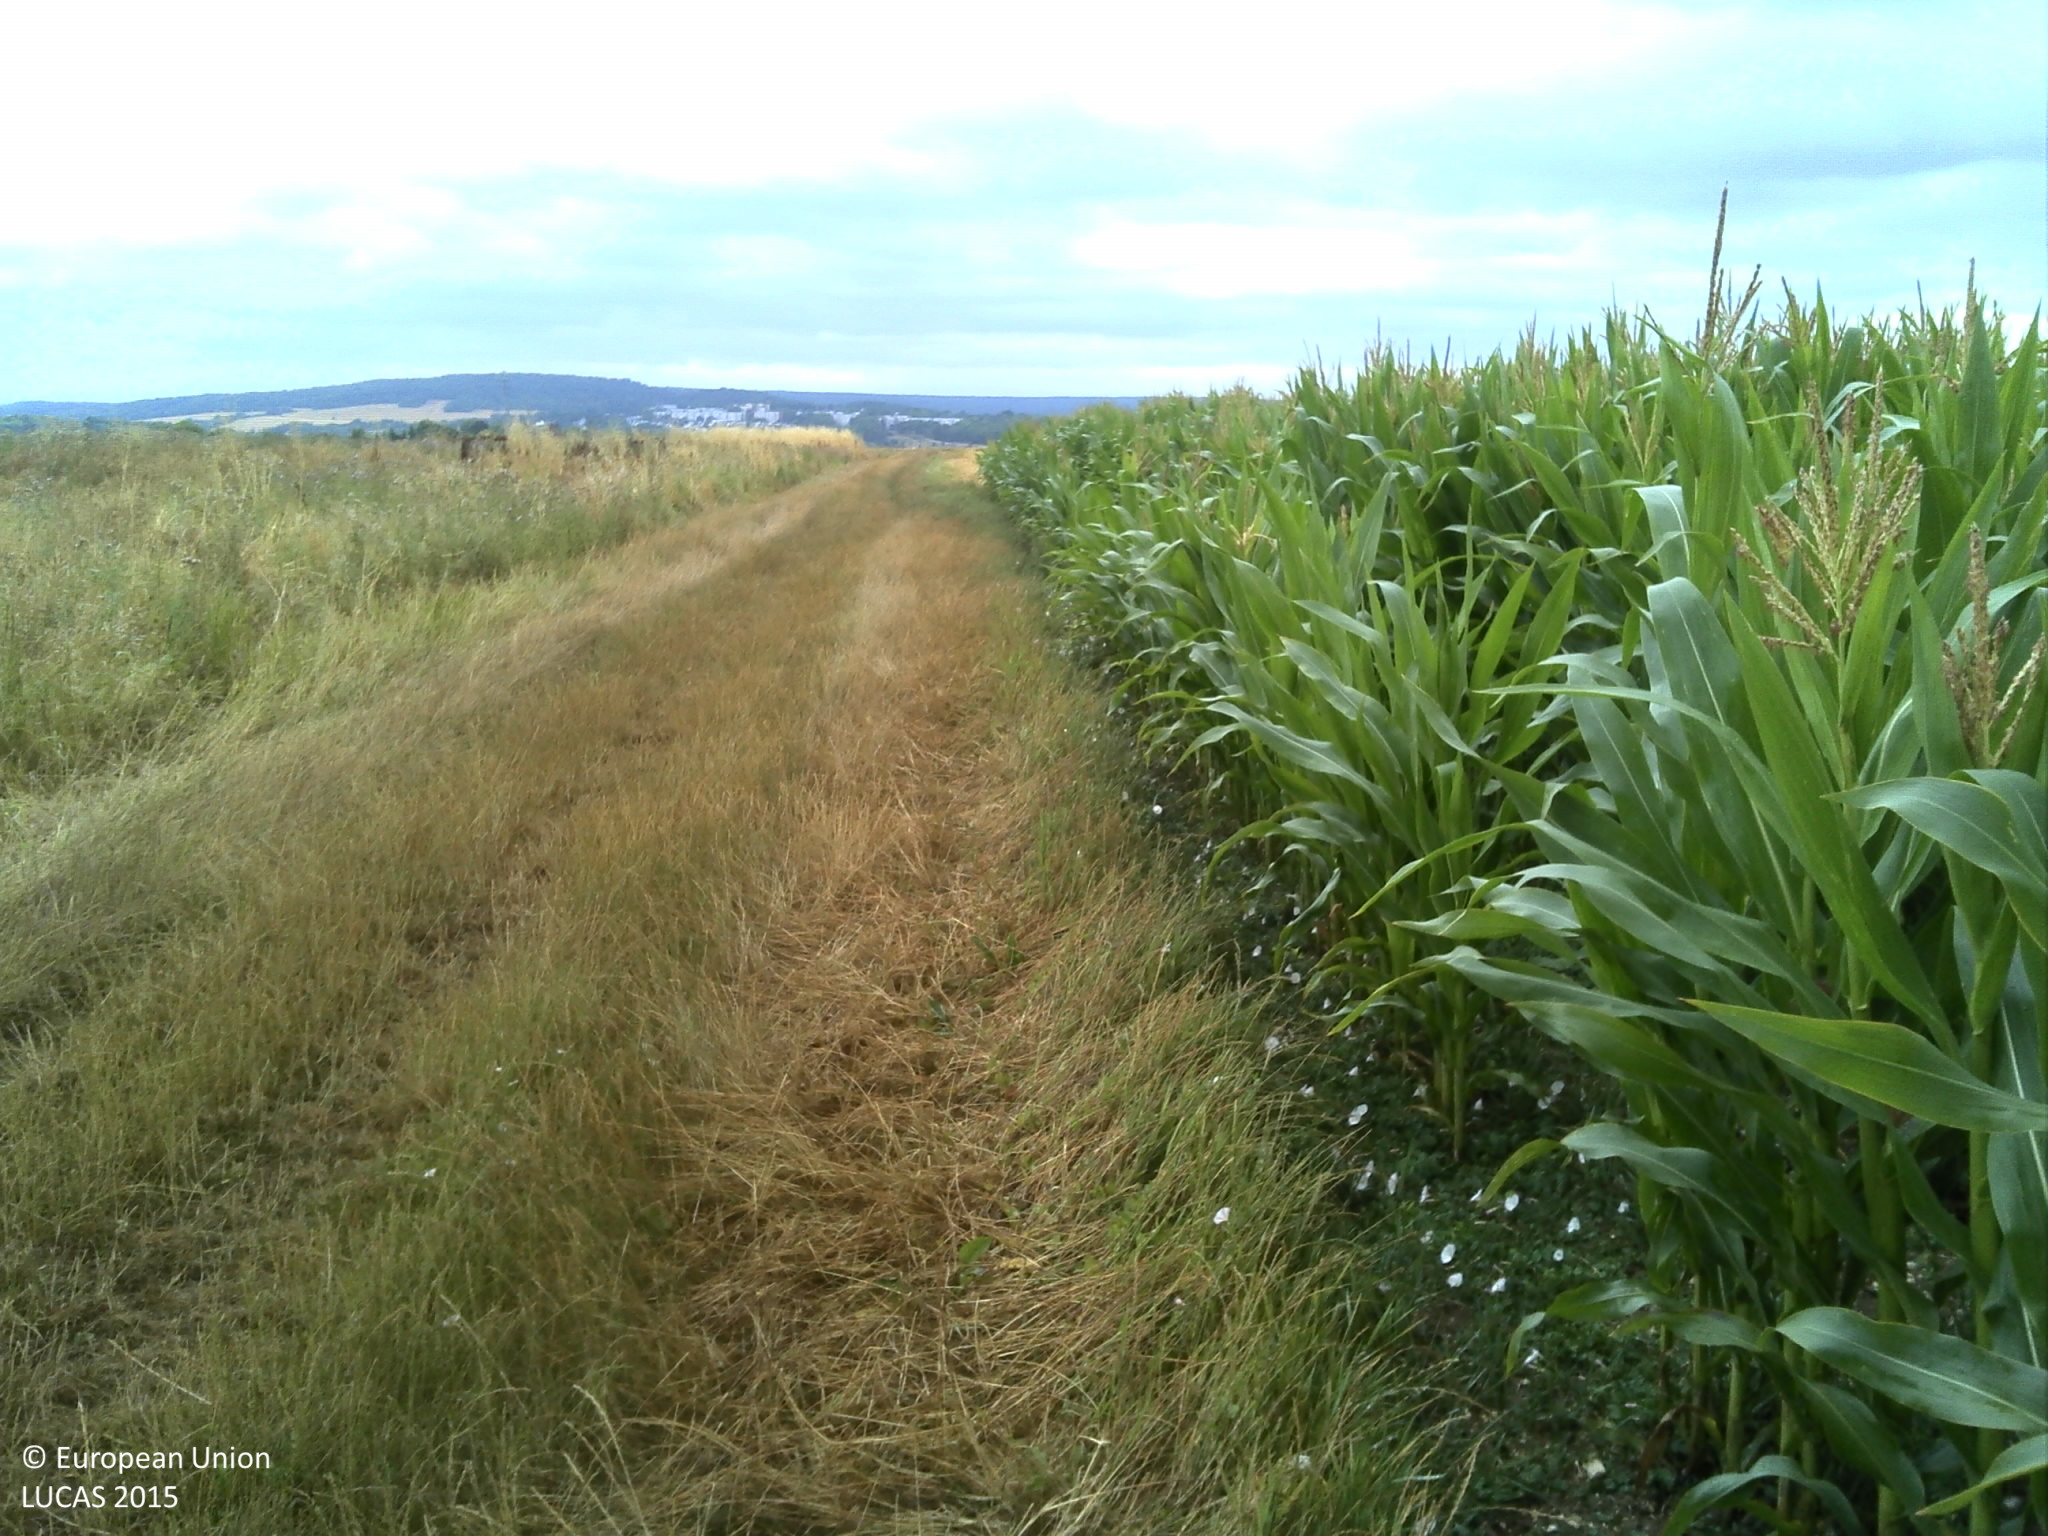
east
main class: Cropland
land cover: Maize
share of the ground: > 75 %
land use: Agriculture (excluding fallow land and kitchen gardens)
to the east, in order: Maize; Common wheat; Grass margins; Tracks; Grass margins; Common wheat
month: July
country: FR
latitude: 49.0084
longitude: 1.8778
